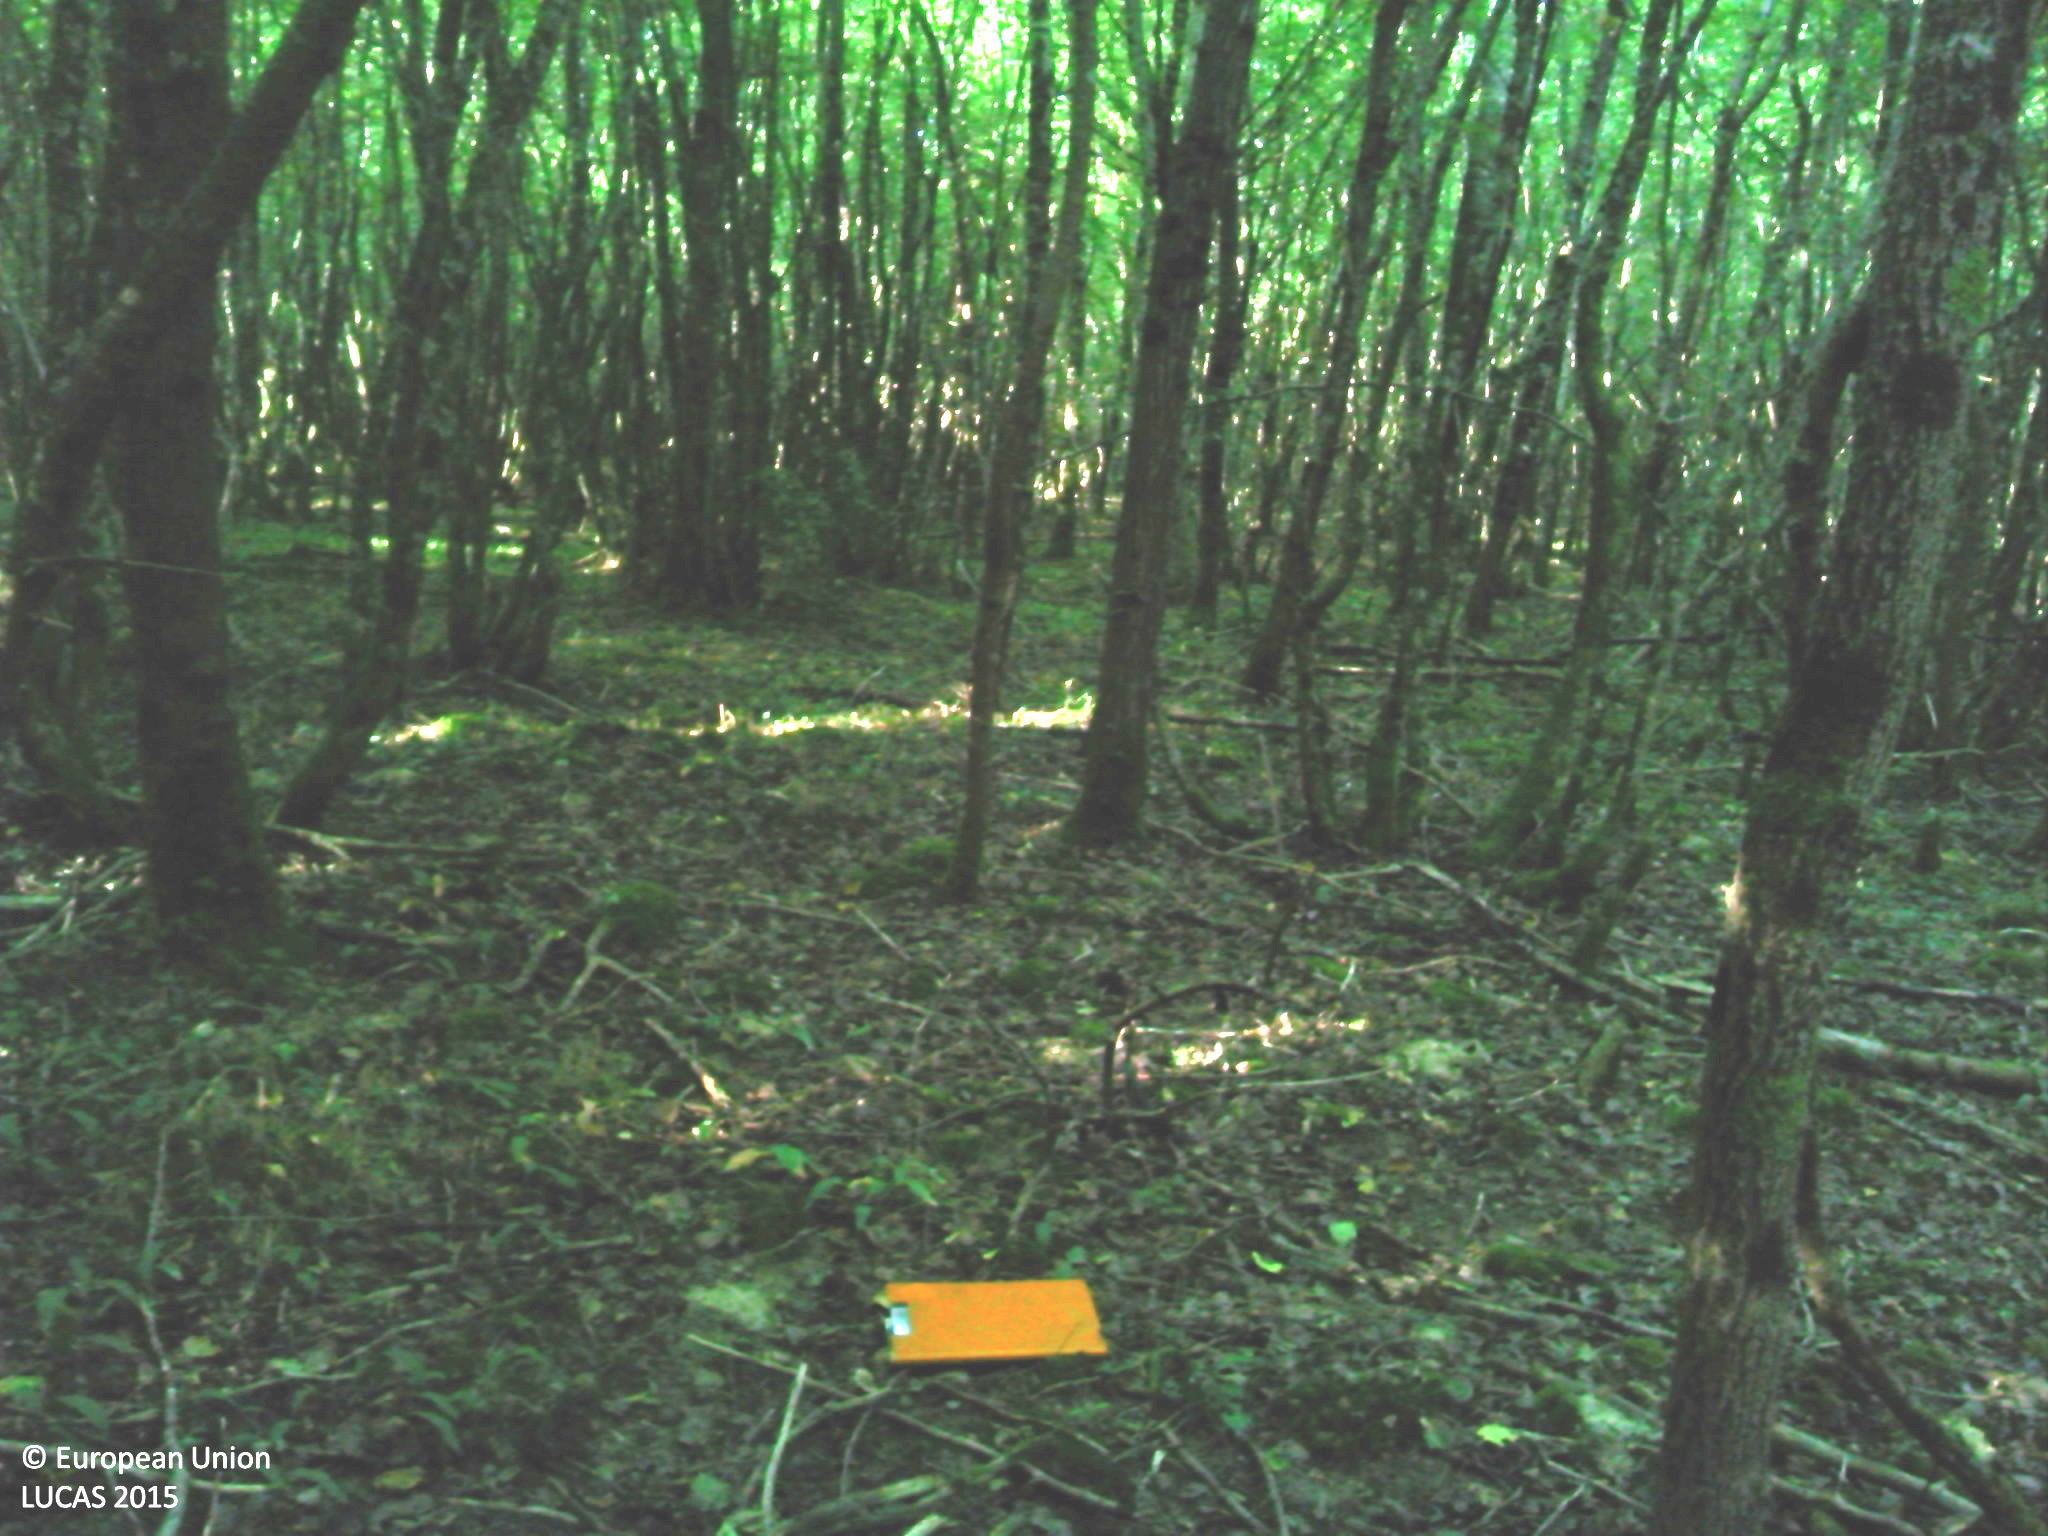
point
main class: Woodland
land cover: Broadleaved woodland
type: mesophytic deciduous forest
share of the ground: > 75 %
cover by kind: broadleaved forest trees 100 %
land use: Forestry
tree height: > 5 m
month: July
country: FR
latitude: 47.0052
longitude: 3.2494
